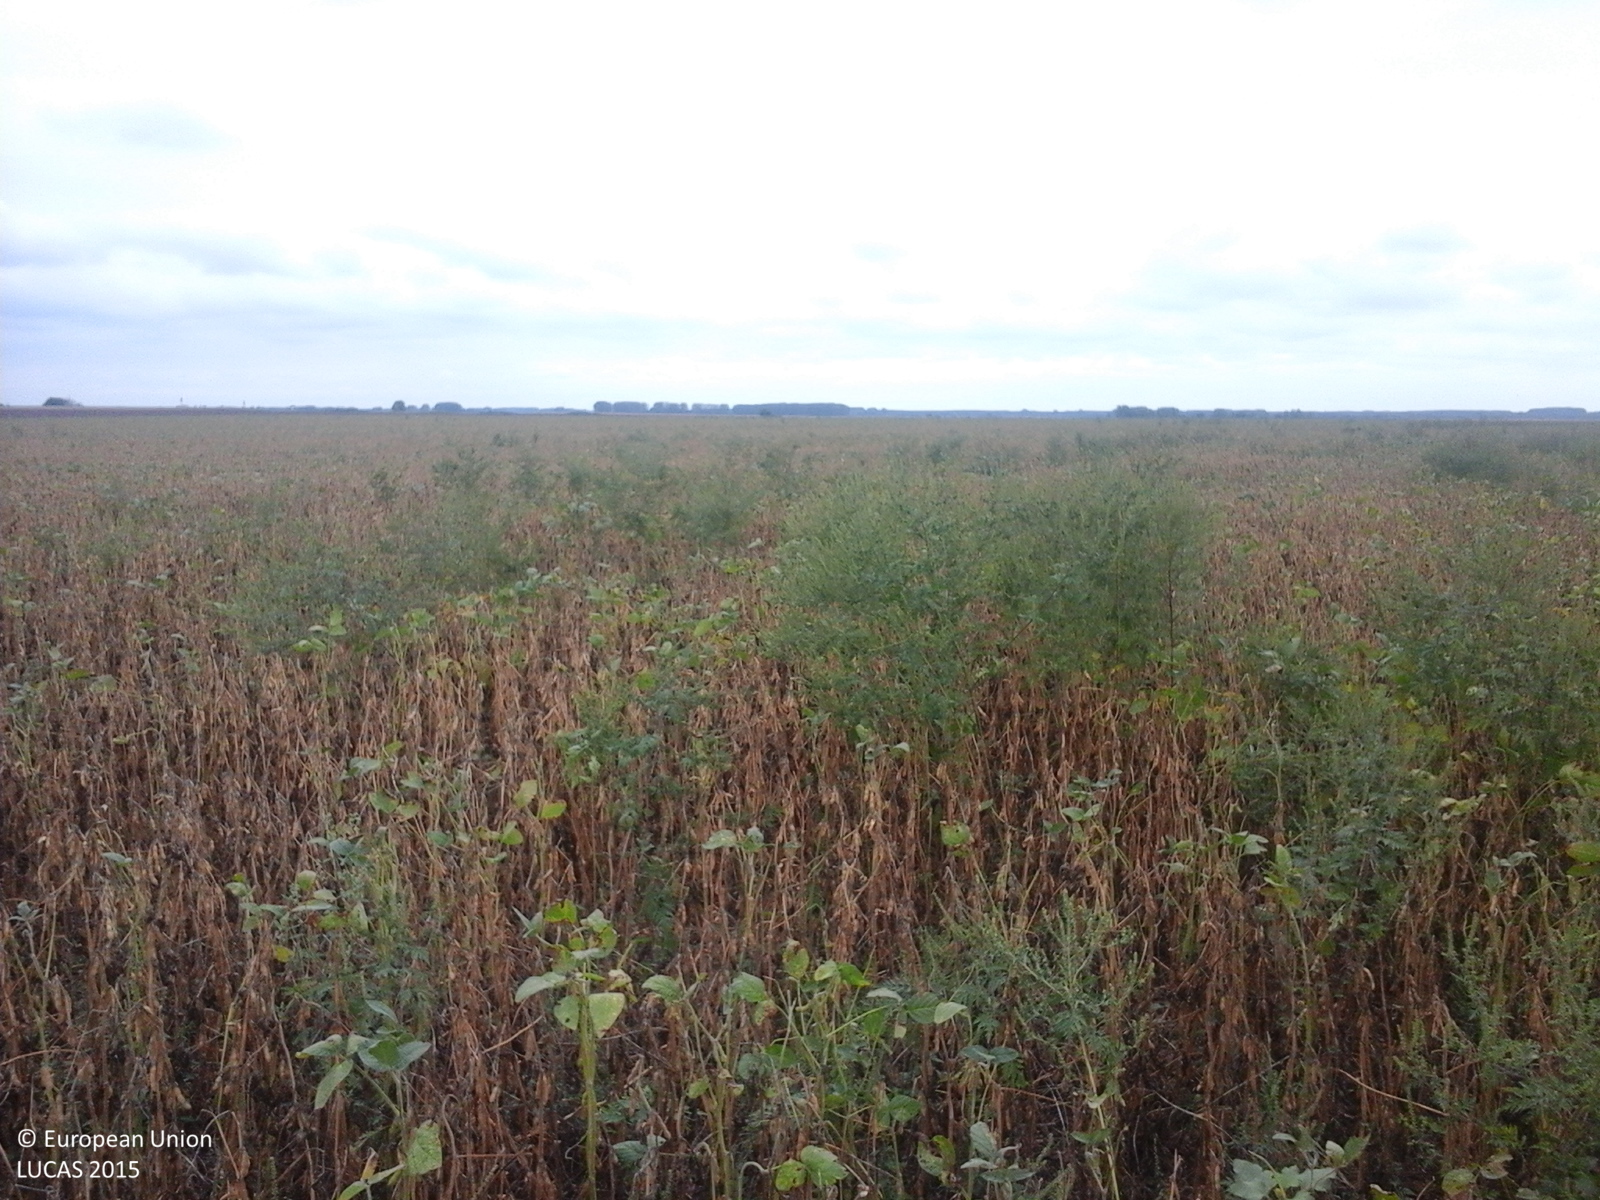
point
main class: Cropland
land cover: Soya
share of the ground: > 75 %
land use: Agriculture (excluding fallow land and kitchen gardens)
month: September
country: RO
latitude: 47.3704
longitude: 21.9535
